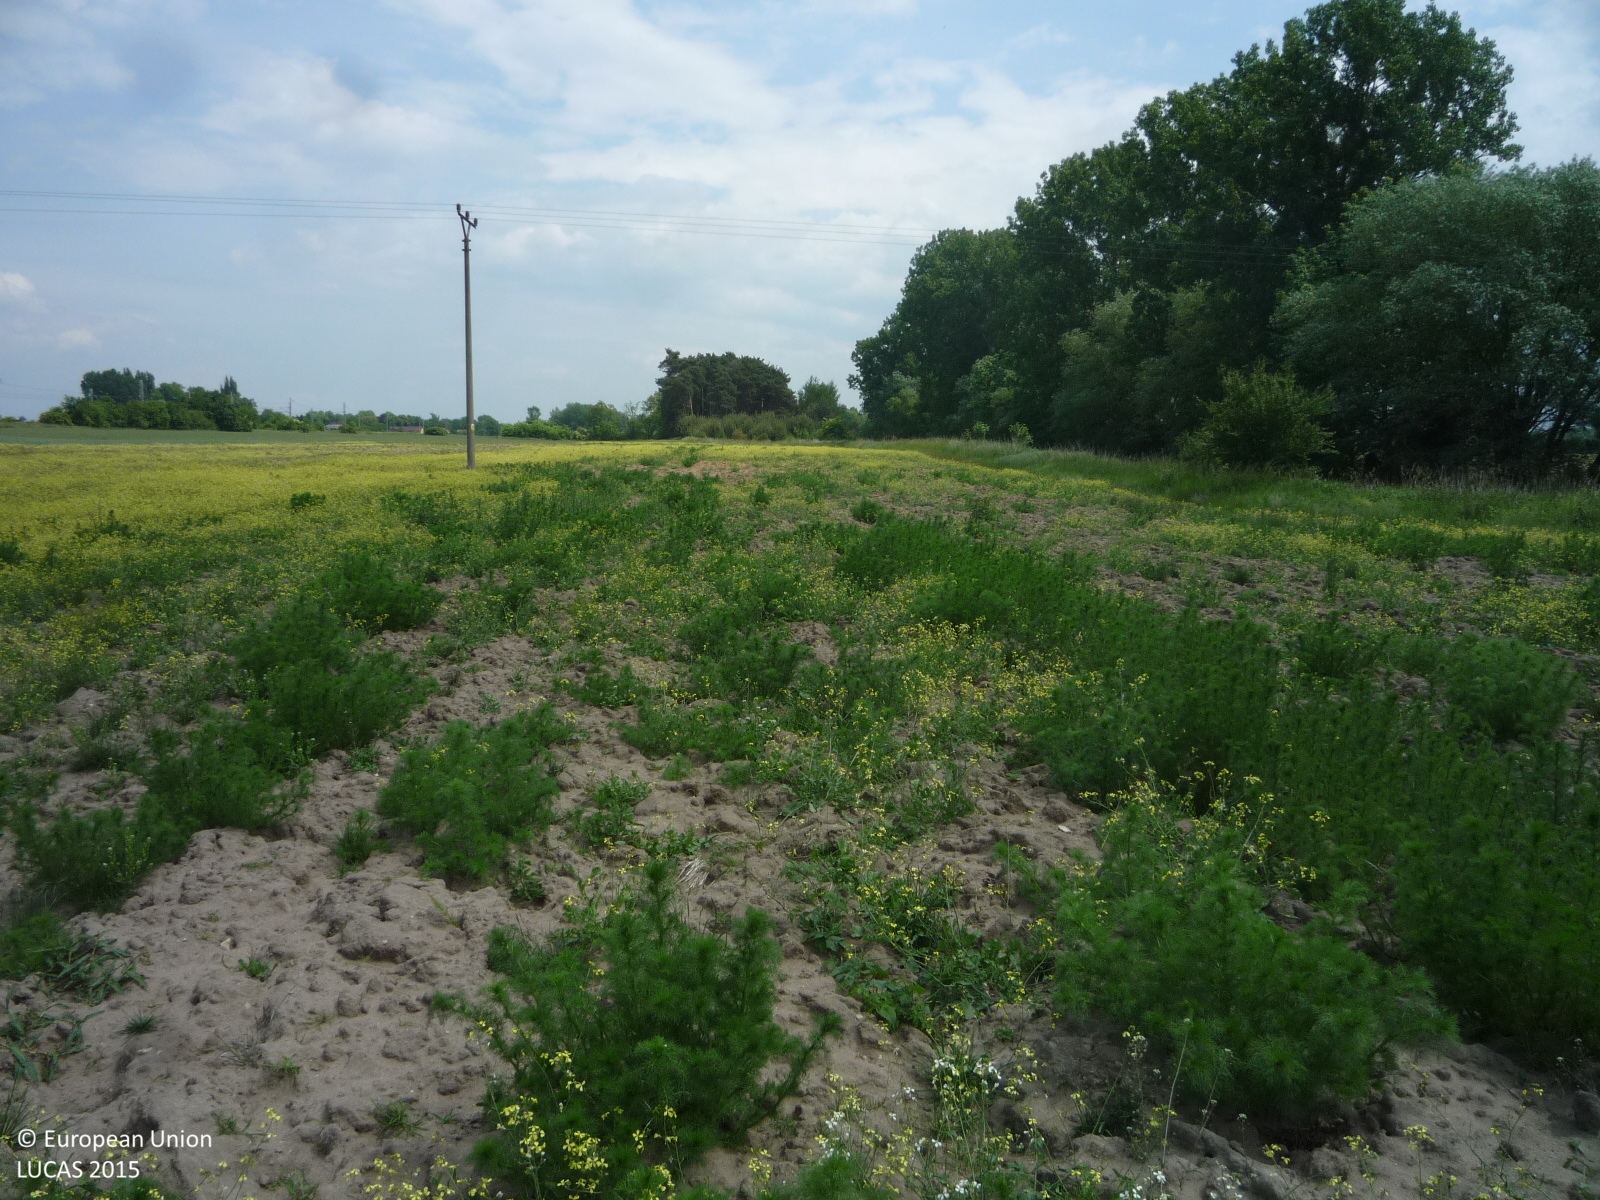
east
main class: Grassland
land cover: Spontaneously vegetated surfaces
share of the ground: 25 - 50 %
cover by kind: unconsolidated bare surface 55 %, herbaceous plants 45 %
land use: Fallow land
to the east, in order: Spontaneously vegetated surfaces; Electric lines; Spontaneously vegetated surfaces; Grassland without tree/shrub cover; Grassland with sparse tree/shrub cover; Pine dominated coniferous woodland
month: May
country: CZ
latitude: 50.1863
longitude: 14.9185
